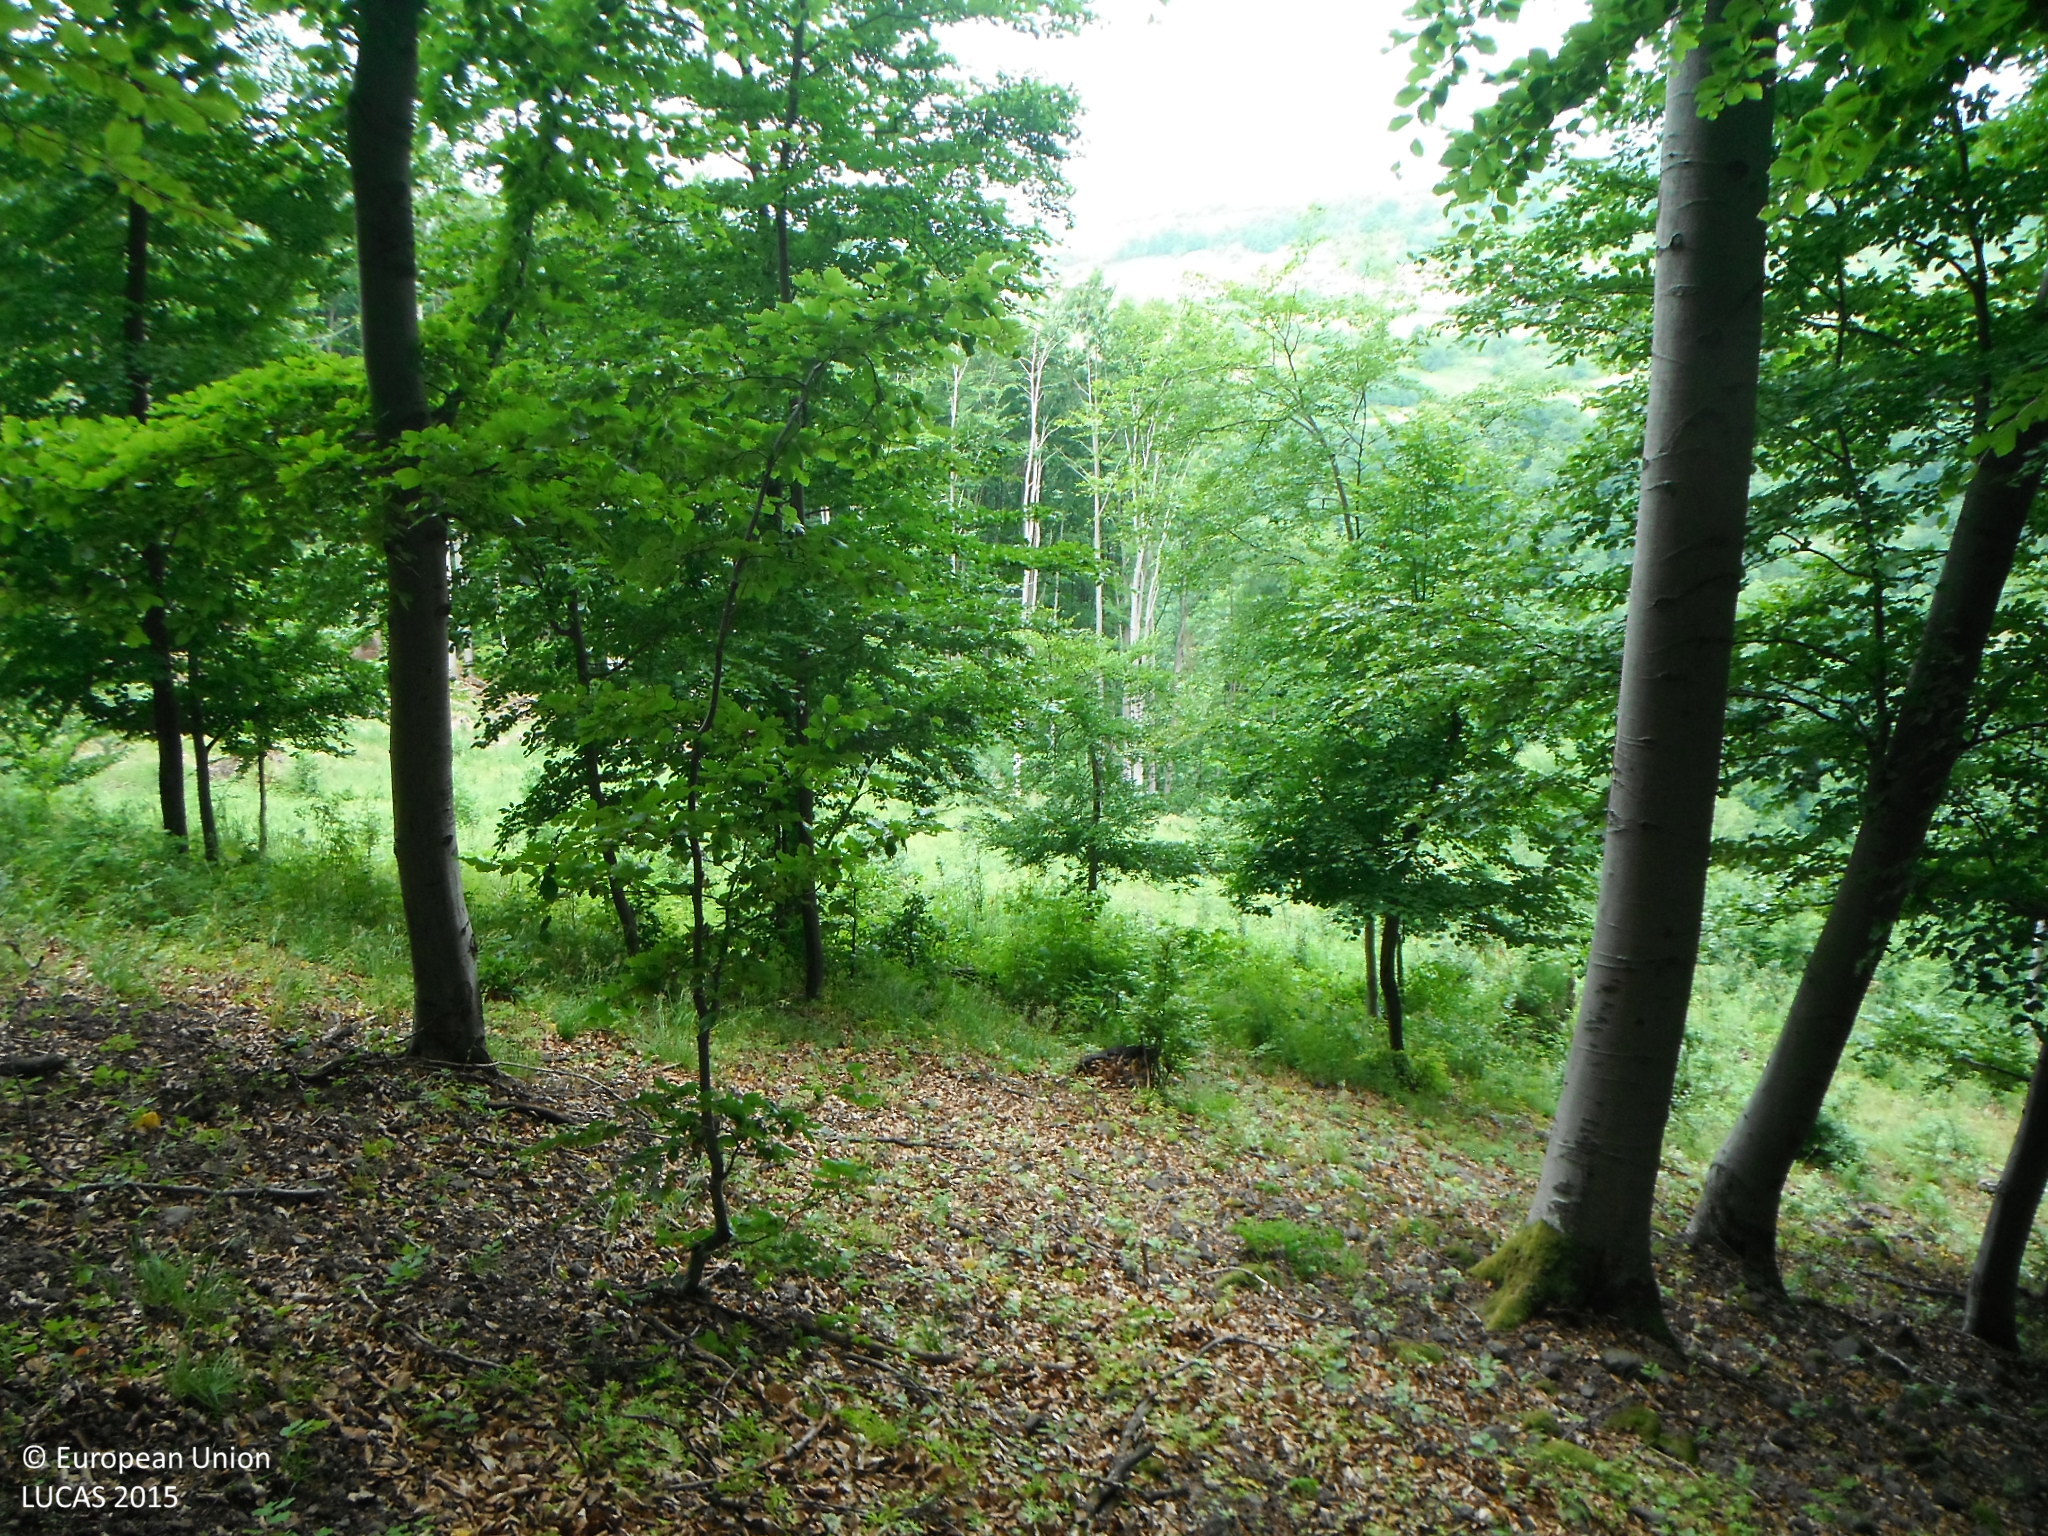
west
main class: Woodland
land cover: Broadleaved woodland
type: mountainous beech forest
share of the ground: > 75 %
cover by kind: broadleaved forest trees 90 %, herbaceous plants 10 %
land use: Forestry
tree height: > 5 m
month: June
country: SK
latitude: 48.6429
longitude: 19.3204
